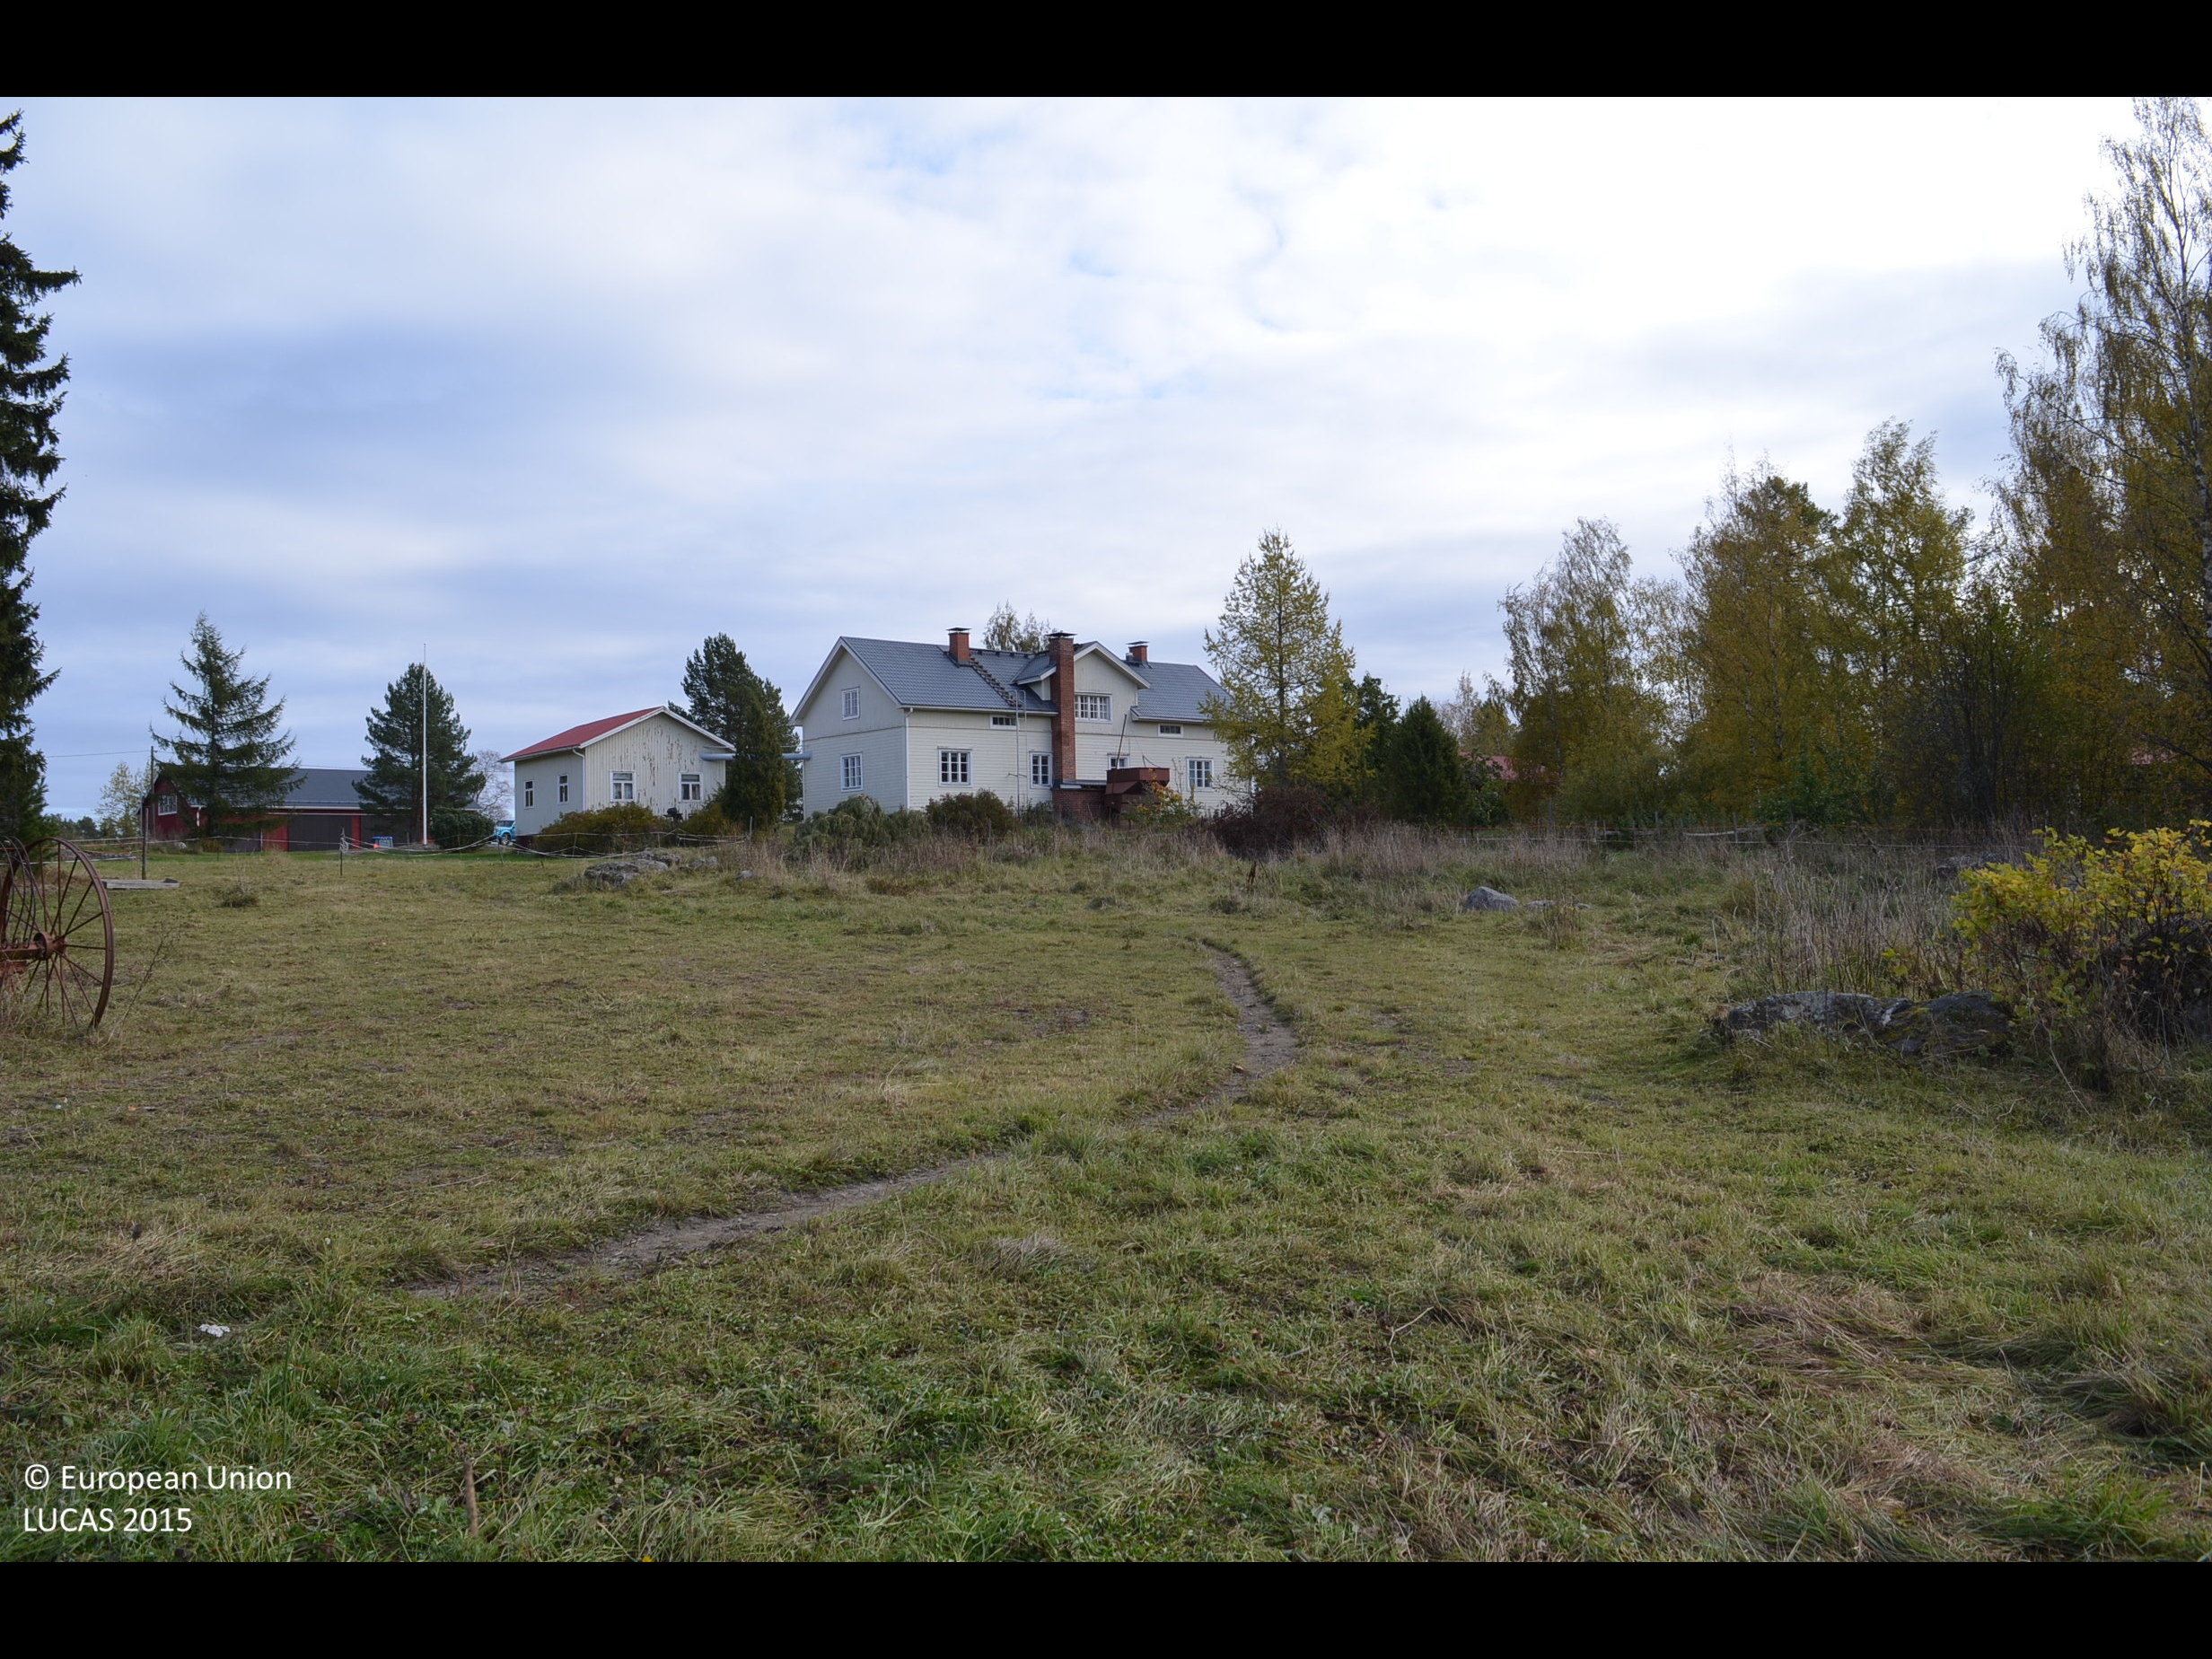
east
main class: Grassland
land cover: Grassland with sparse tree/shrub cover
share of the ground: > 75 %
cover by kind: herbaceous plants 80 %, unconsolidated bare surface 10 %, coniferous forest trees 5 %, shrubs 5 %
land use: Fallow land
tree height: > 5 m
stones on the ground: < 10 %
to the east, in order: Grassland with sparse tree/shrub cover; Artificial constructions in urban areas; Temporary grasslands
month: October
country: FI
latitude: 61.6597
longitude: 23.8121
